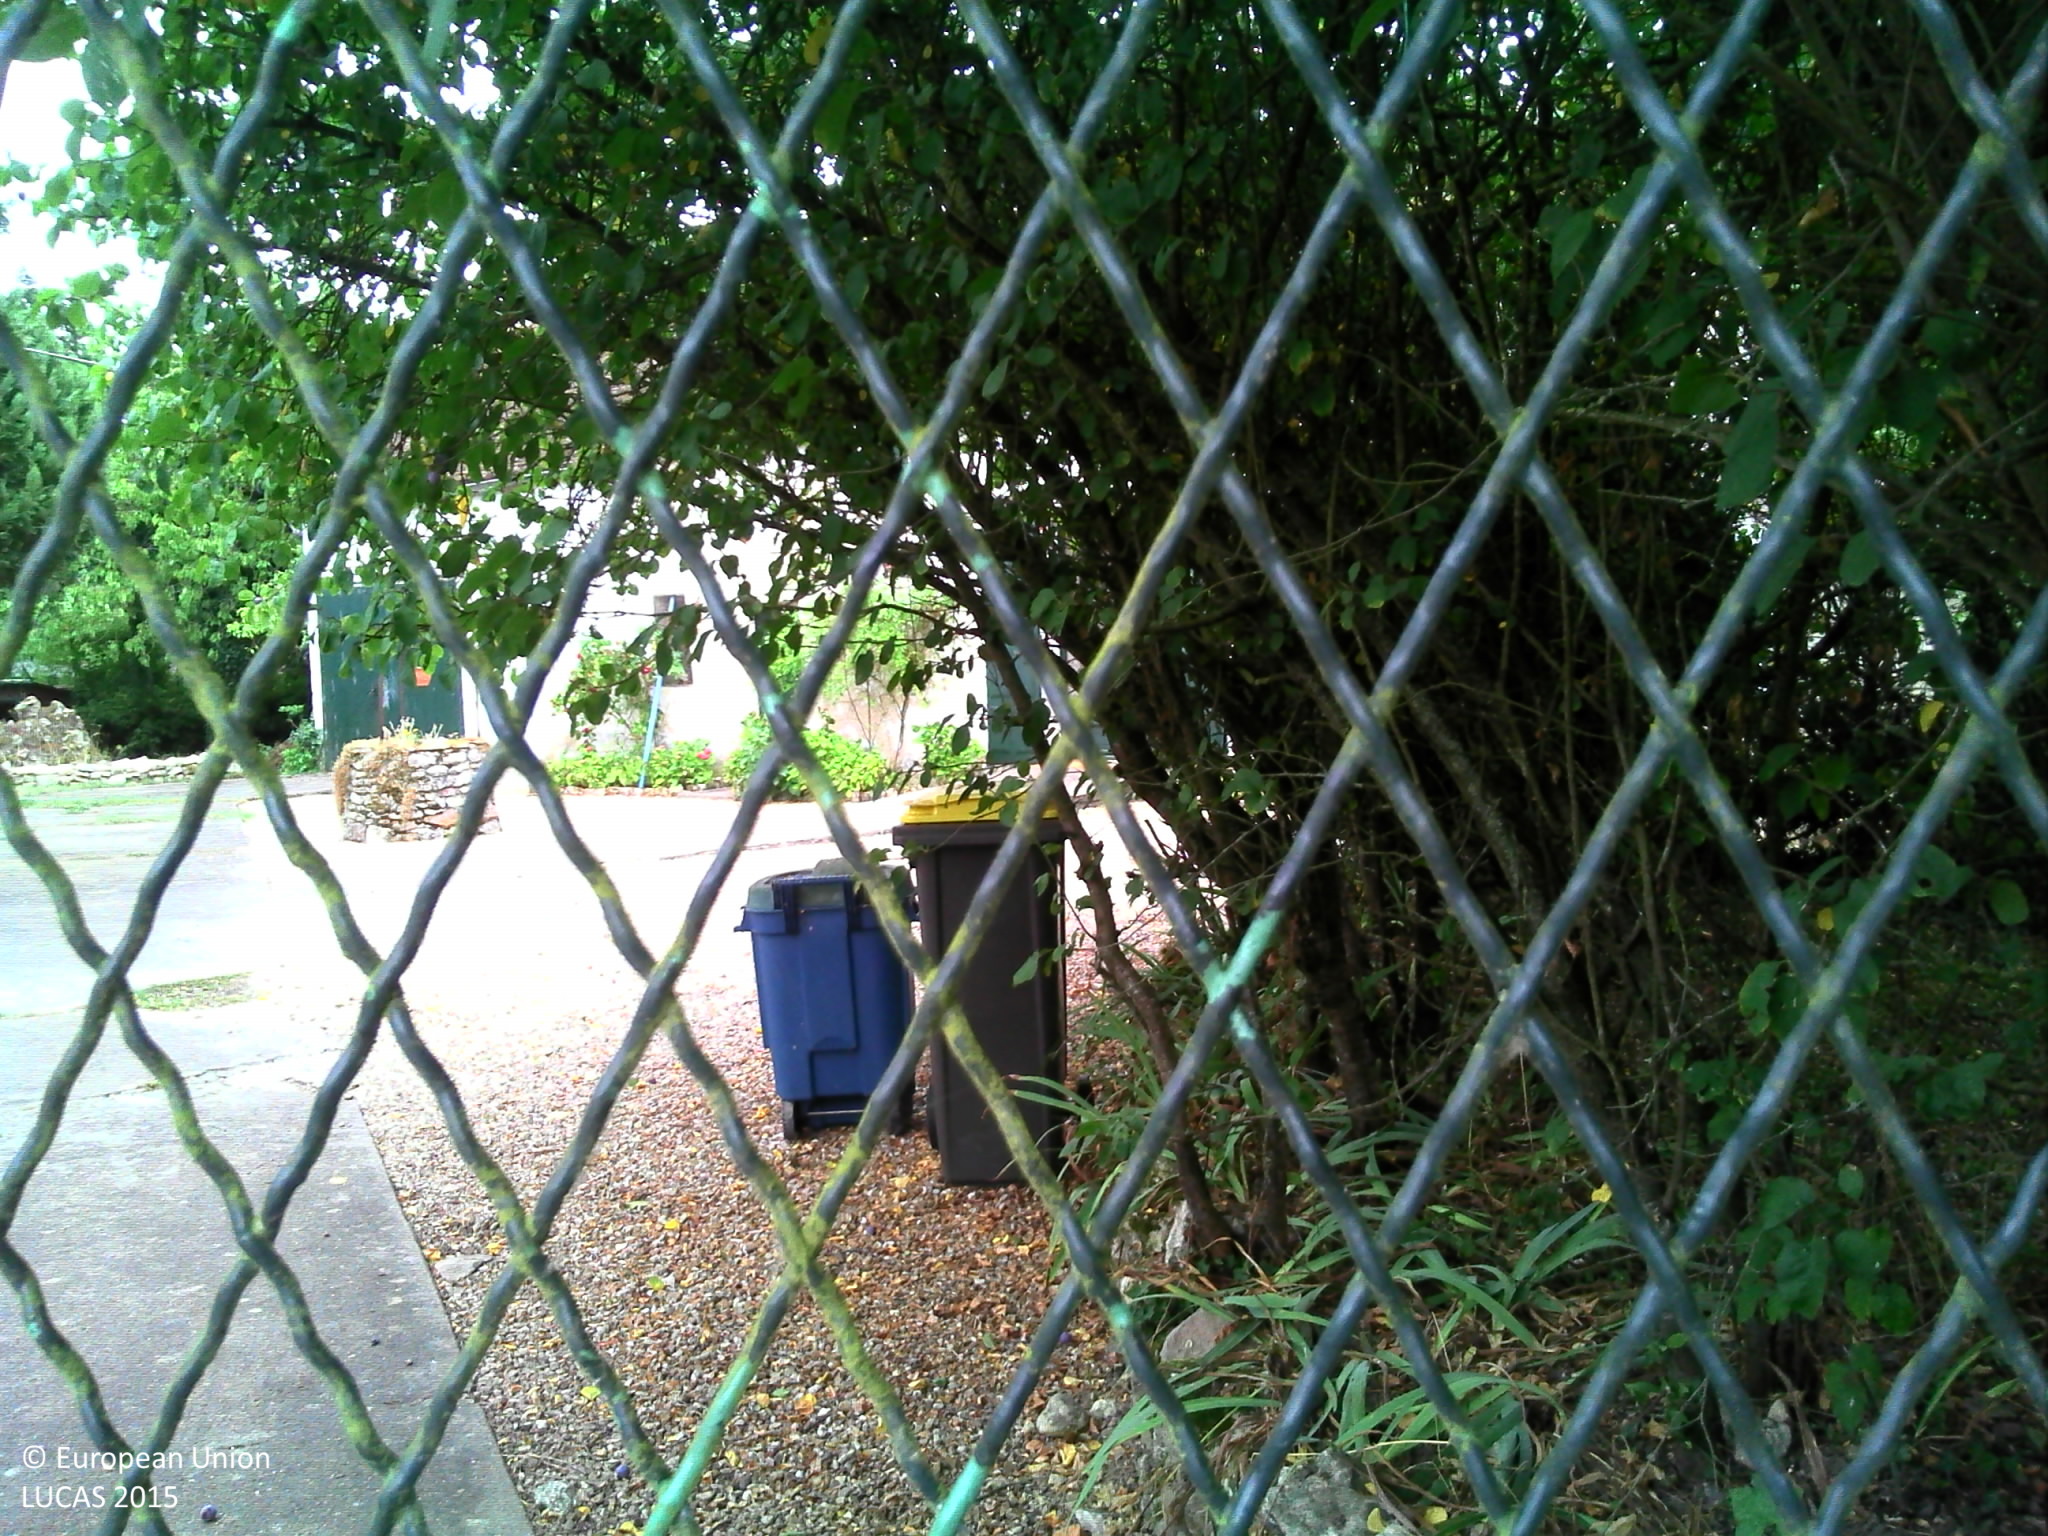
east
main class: Woodland
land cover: Broadleaved woodland
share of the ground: > 75 %
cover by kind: broadleaved forest trees 100 %
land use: Residential
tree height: > 5 m
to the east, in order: Broadleaved woodland; Artificial constructions in urban areas; Grassland without tree/shrub cover; Broadleaved woodland
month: July
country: FR
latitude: 48.0934
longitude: 2.7545
